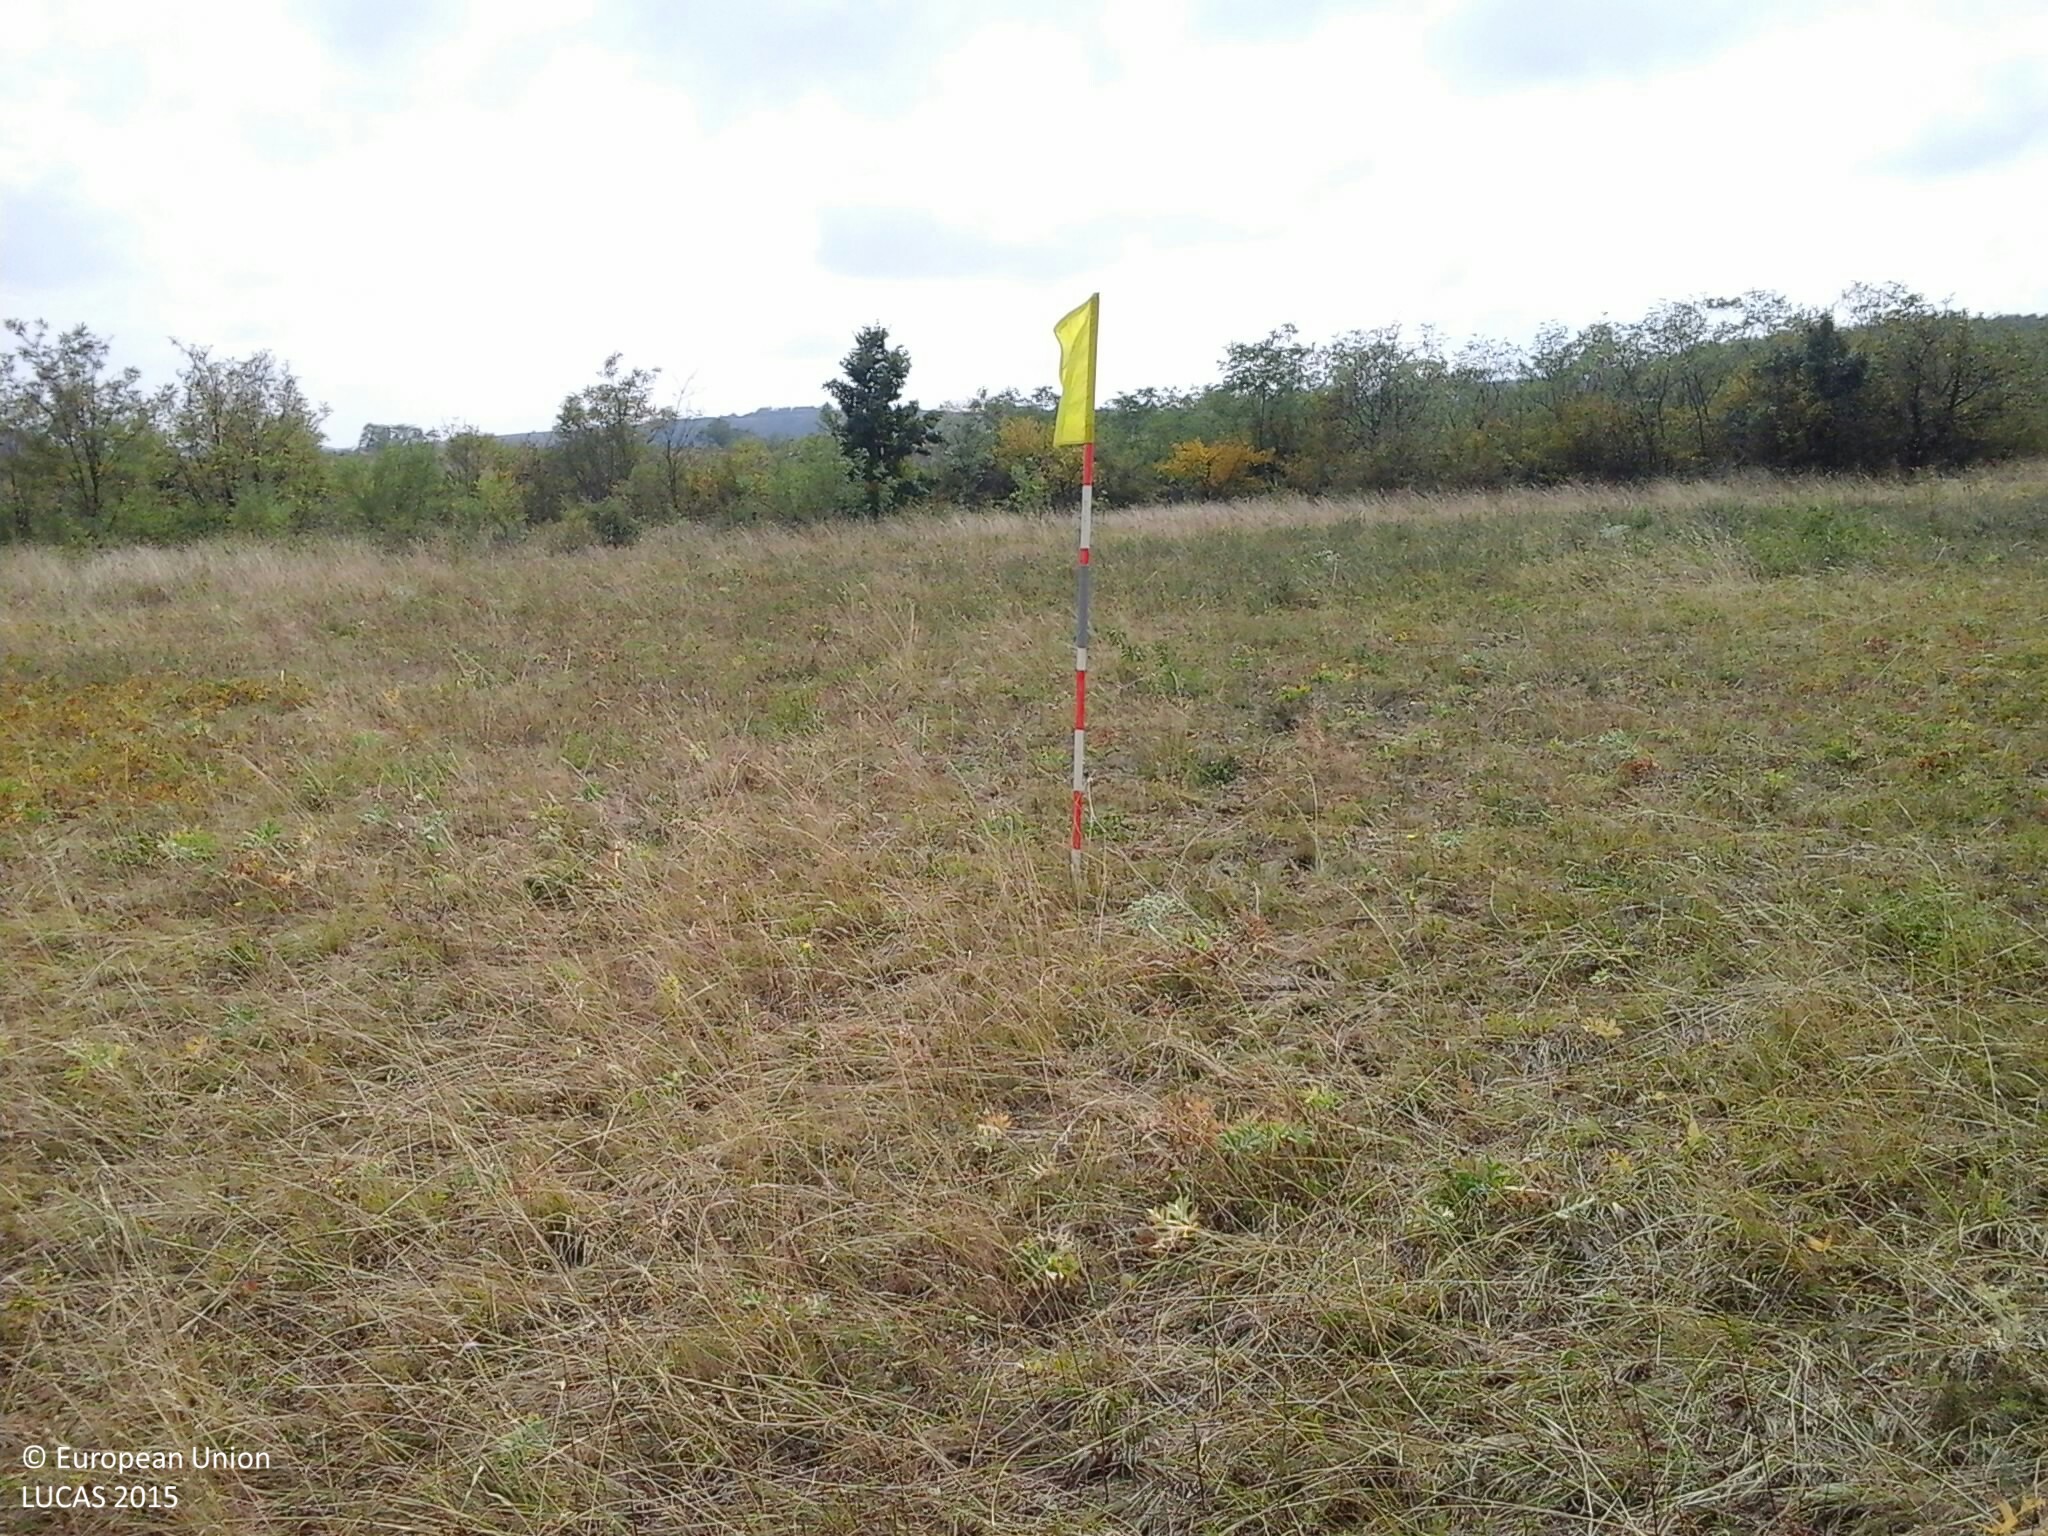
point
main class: Grassland
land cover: Grassland without tree/shrub cover
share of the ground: > 75 %
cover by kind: herbaceous plants 100 %
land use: Agriculture (excluding fallow land and kitchen gardens)
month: August
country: HU
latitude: 47.9775
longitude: 20.6584
